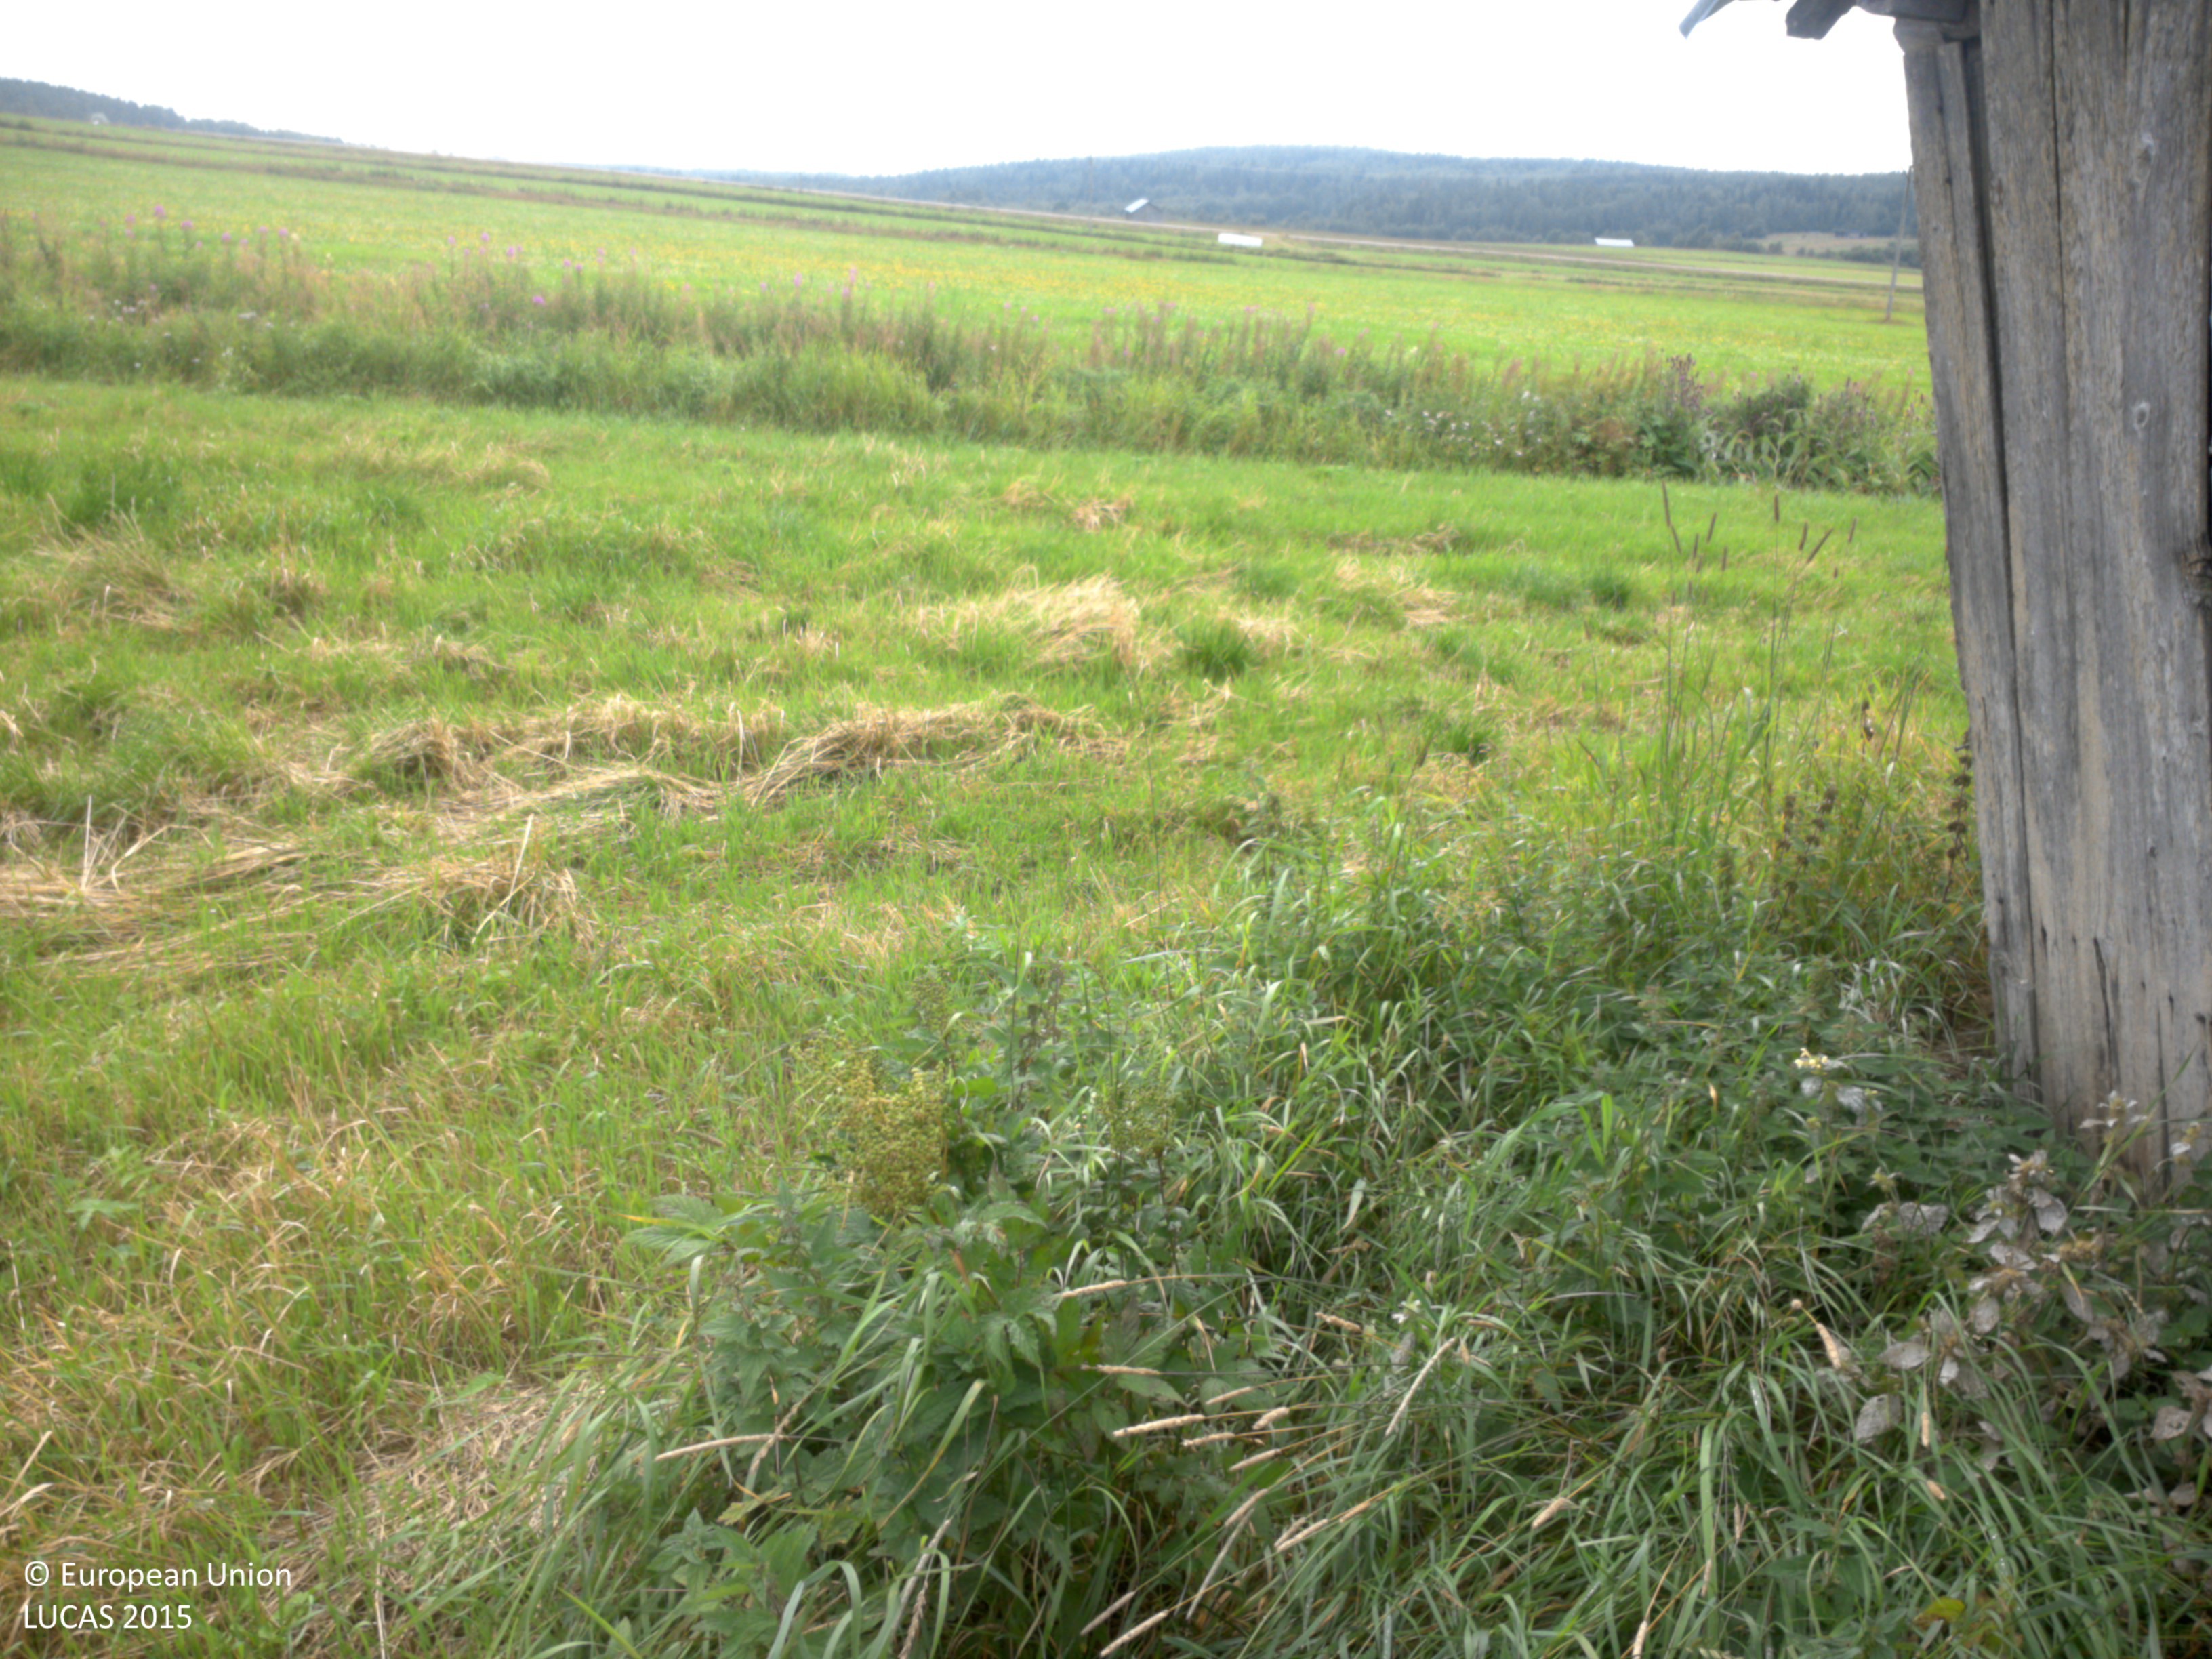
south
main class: Grassland
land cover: Spontaneously vegetated surfaces
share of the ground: > 75 %
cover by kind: herbaceous plants 100 %
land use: Agriculture (excluding fallow land and kitchen gardens)
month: August
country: SE
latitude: 63.7810
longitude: 19.8596
